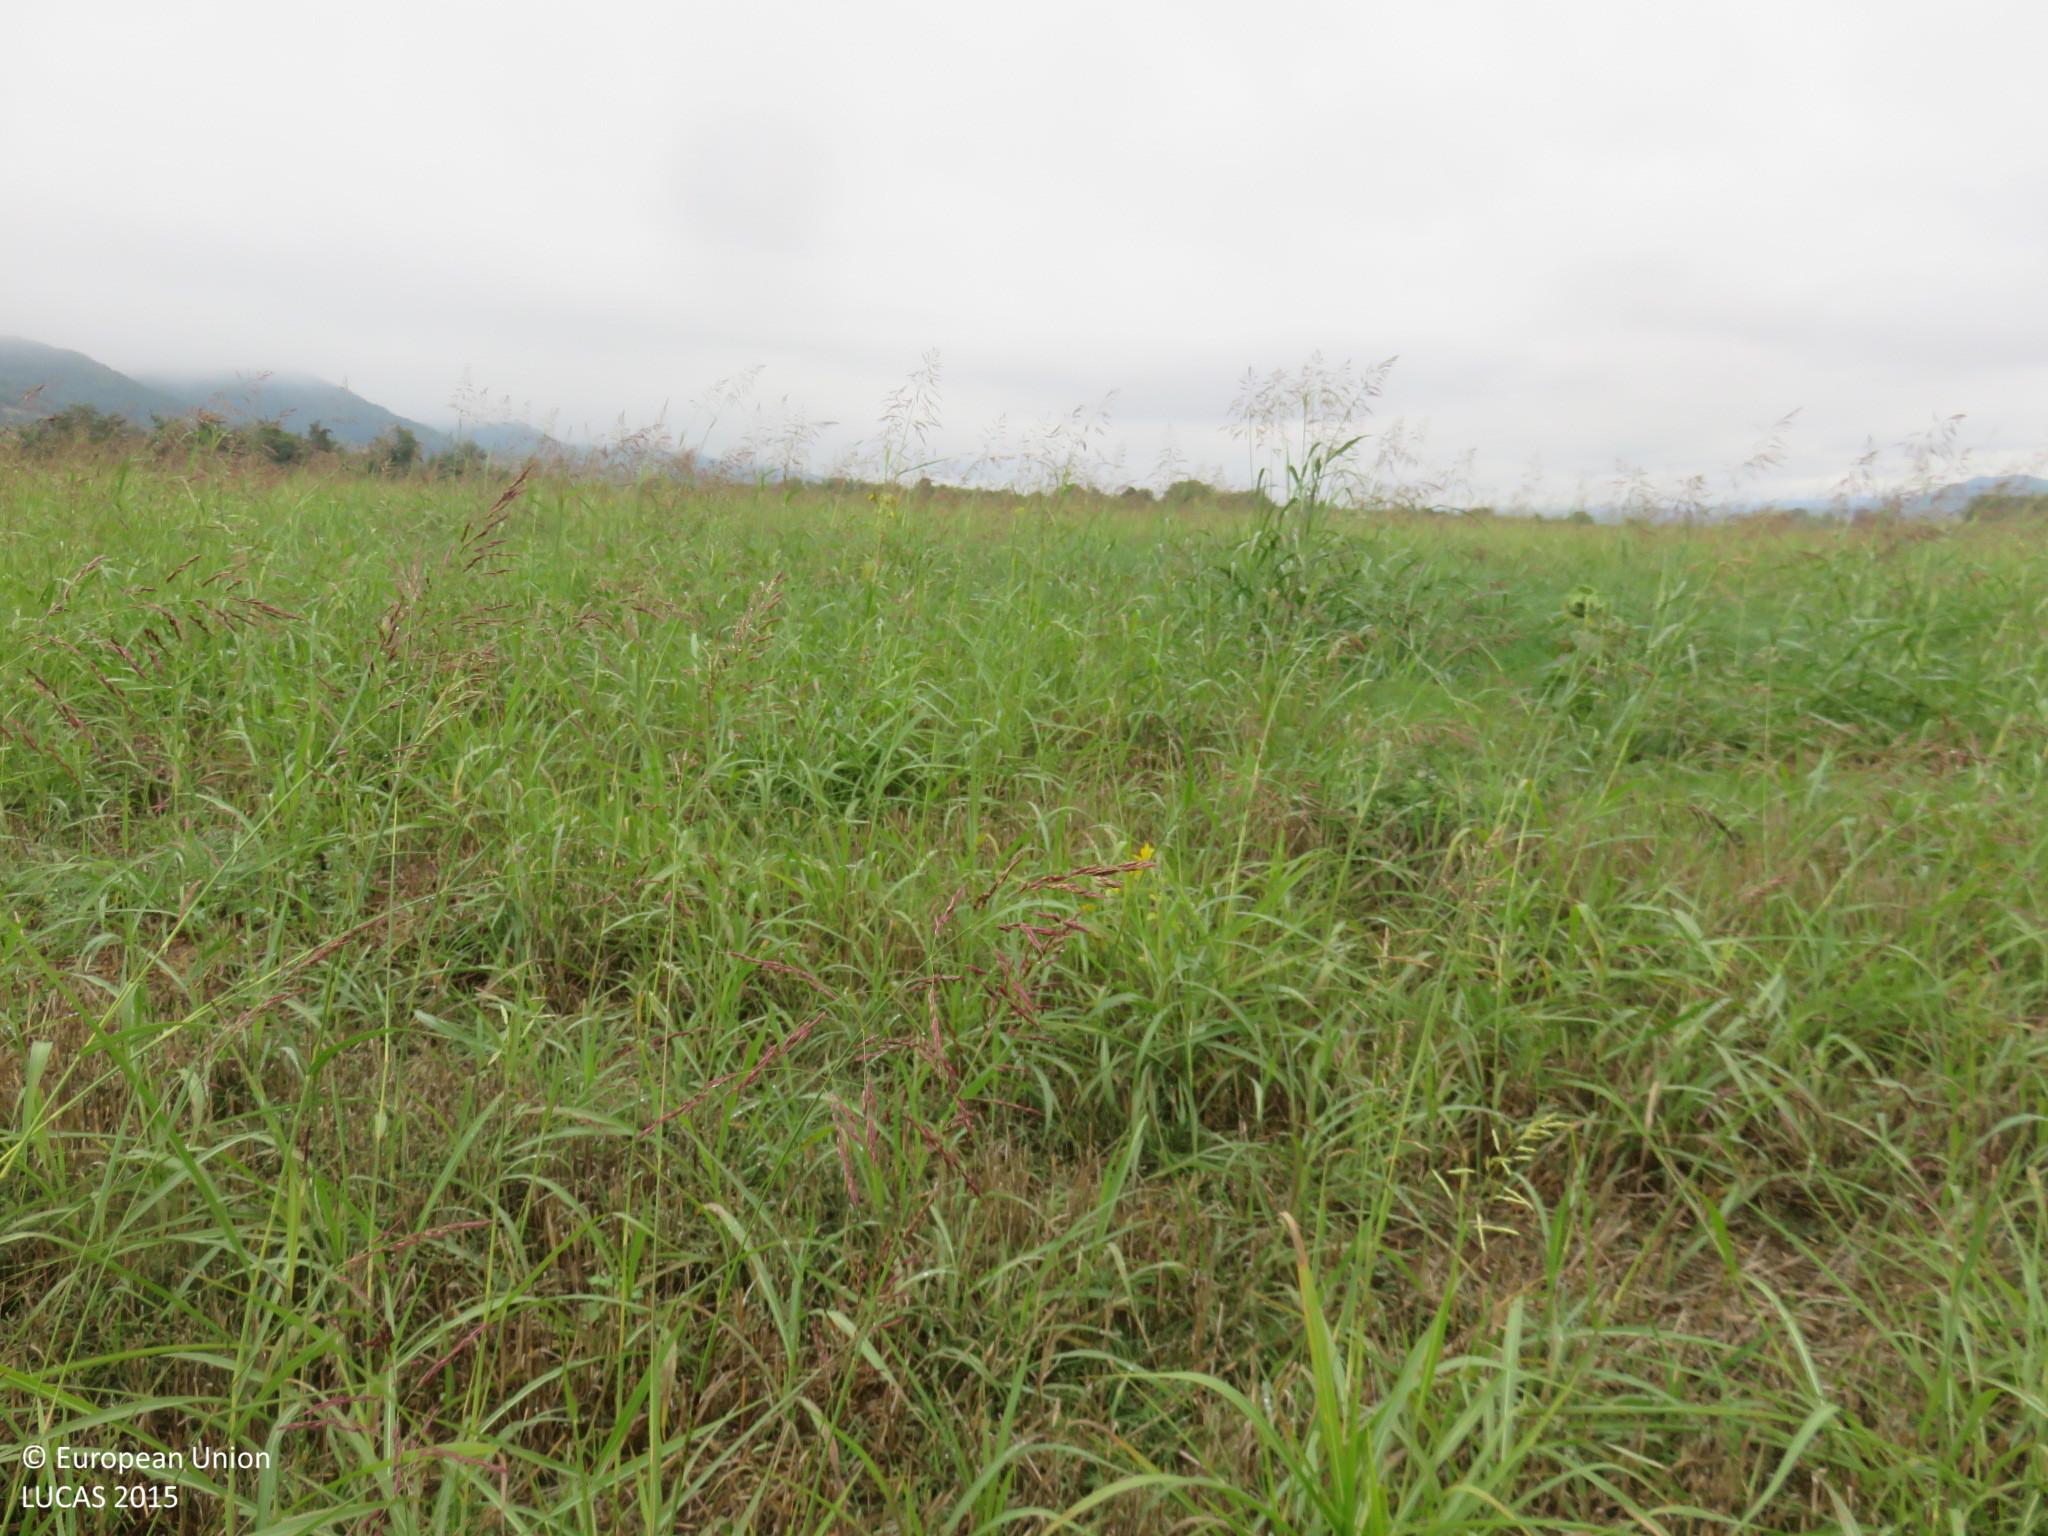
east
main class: Cropland
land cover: Common wheat
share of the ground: < 10 %
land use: Agriculture (excluding fallow land and kitchen gardens)
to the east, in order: Common wheat; Spontaneously vegetated surfaces
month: September
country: BG
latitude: 42.9975
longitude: 24.8686
